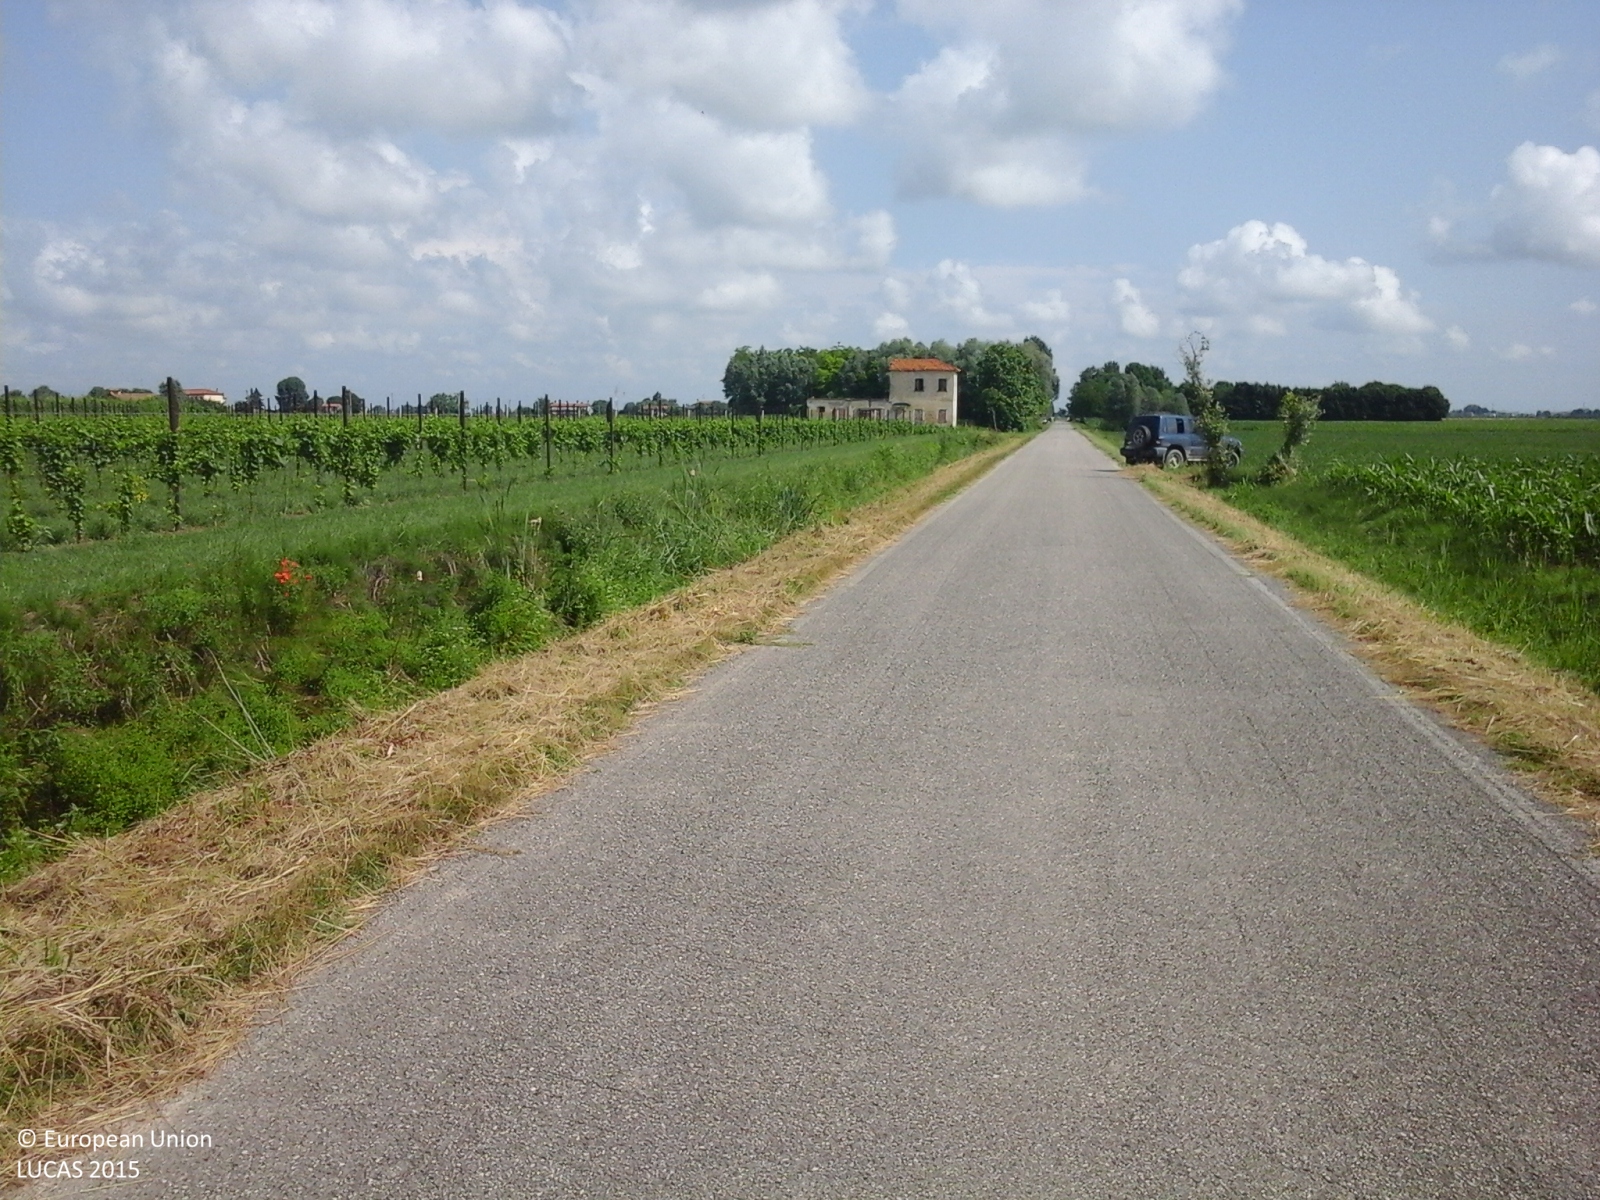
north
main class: Cropland
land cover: Maize
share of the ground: > 75 %
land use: Agriculture (excluding fallow land and kitchen gardens)
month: June
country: IT
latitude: 45.5967
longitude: 12.6755
